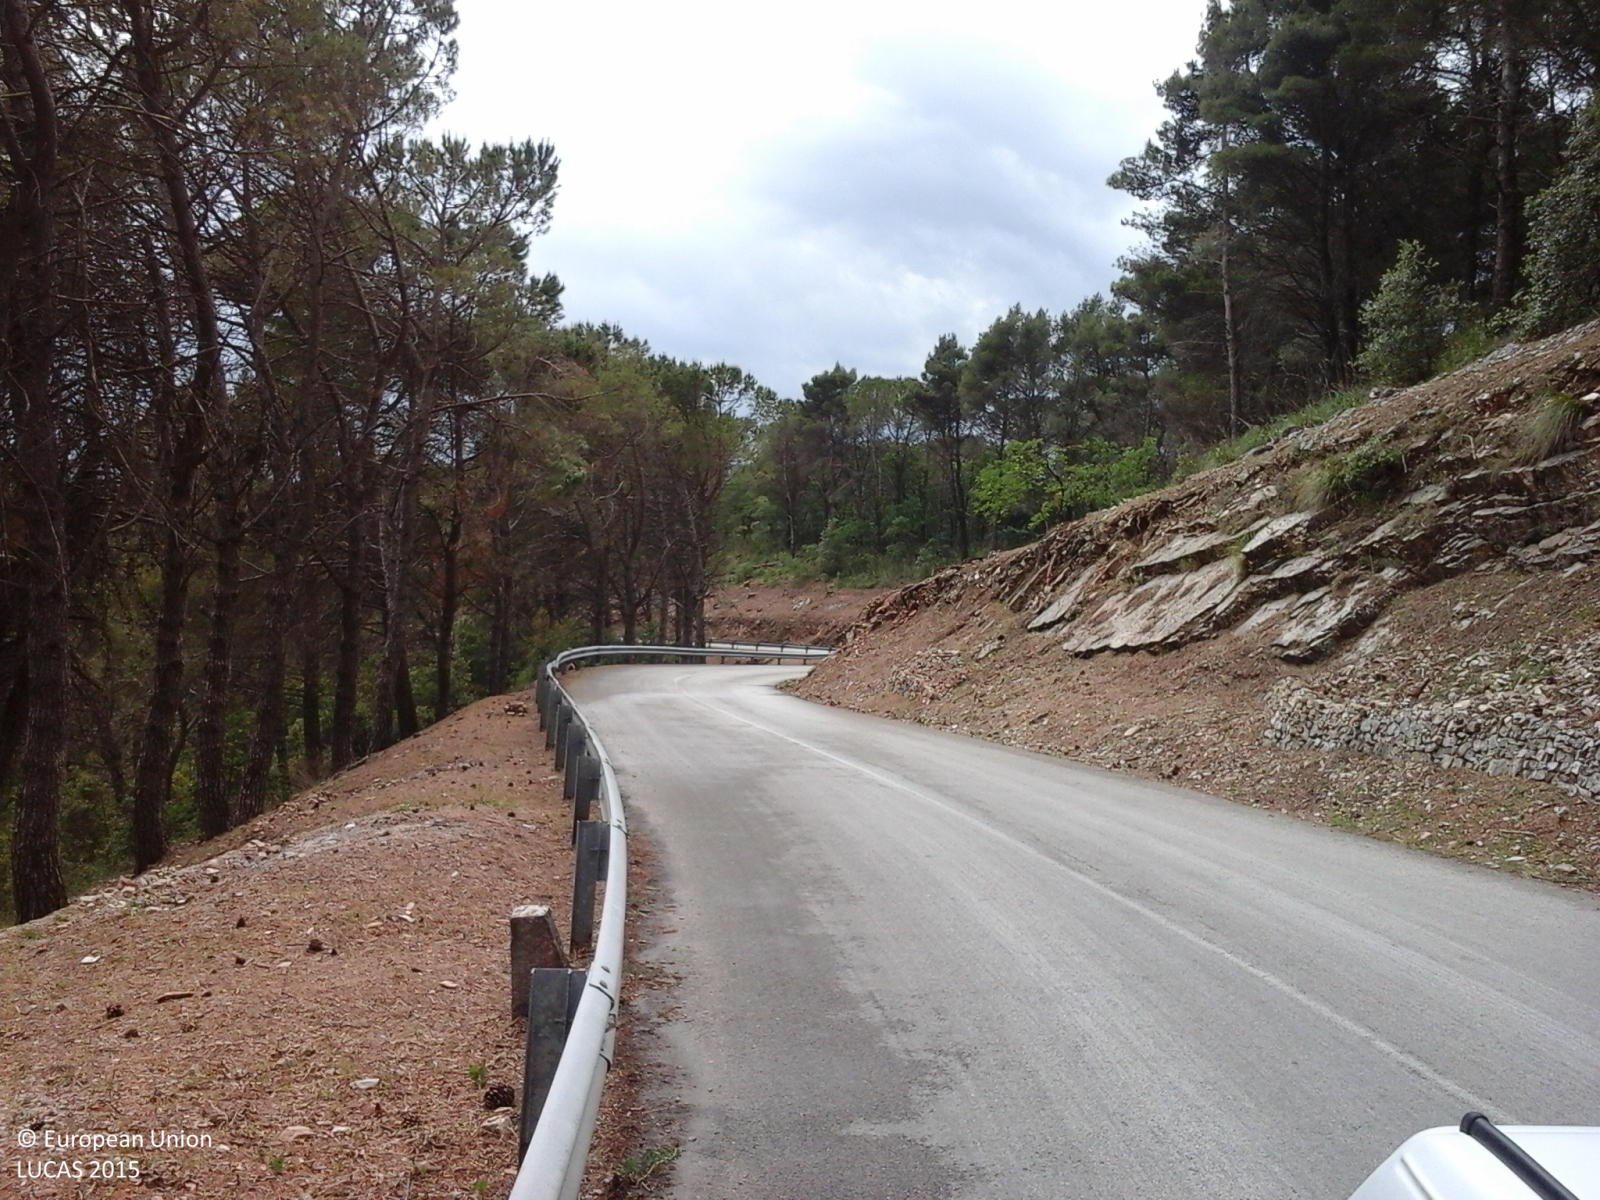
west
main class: Woodland
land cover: Pine dominated mixed woodland
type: coniferous forest of the mediterranean region
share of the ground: > 75 %
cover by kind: coniferous forest trees 50 %, broadleaved forest trees 30 %, shrubs 15 %, herbaceous plants 5 %
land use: Forestry
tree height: > 5 m
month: June
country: IT
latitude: 37.6089
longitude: 13.5418
